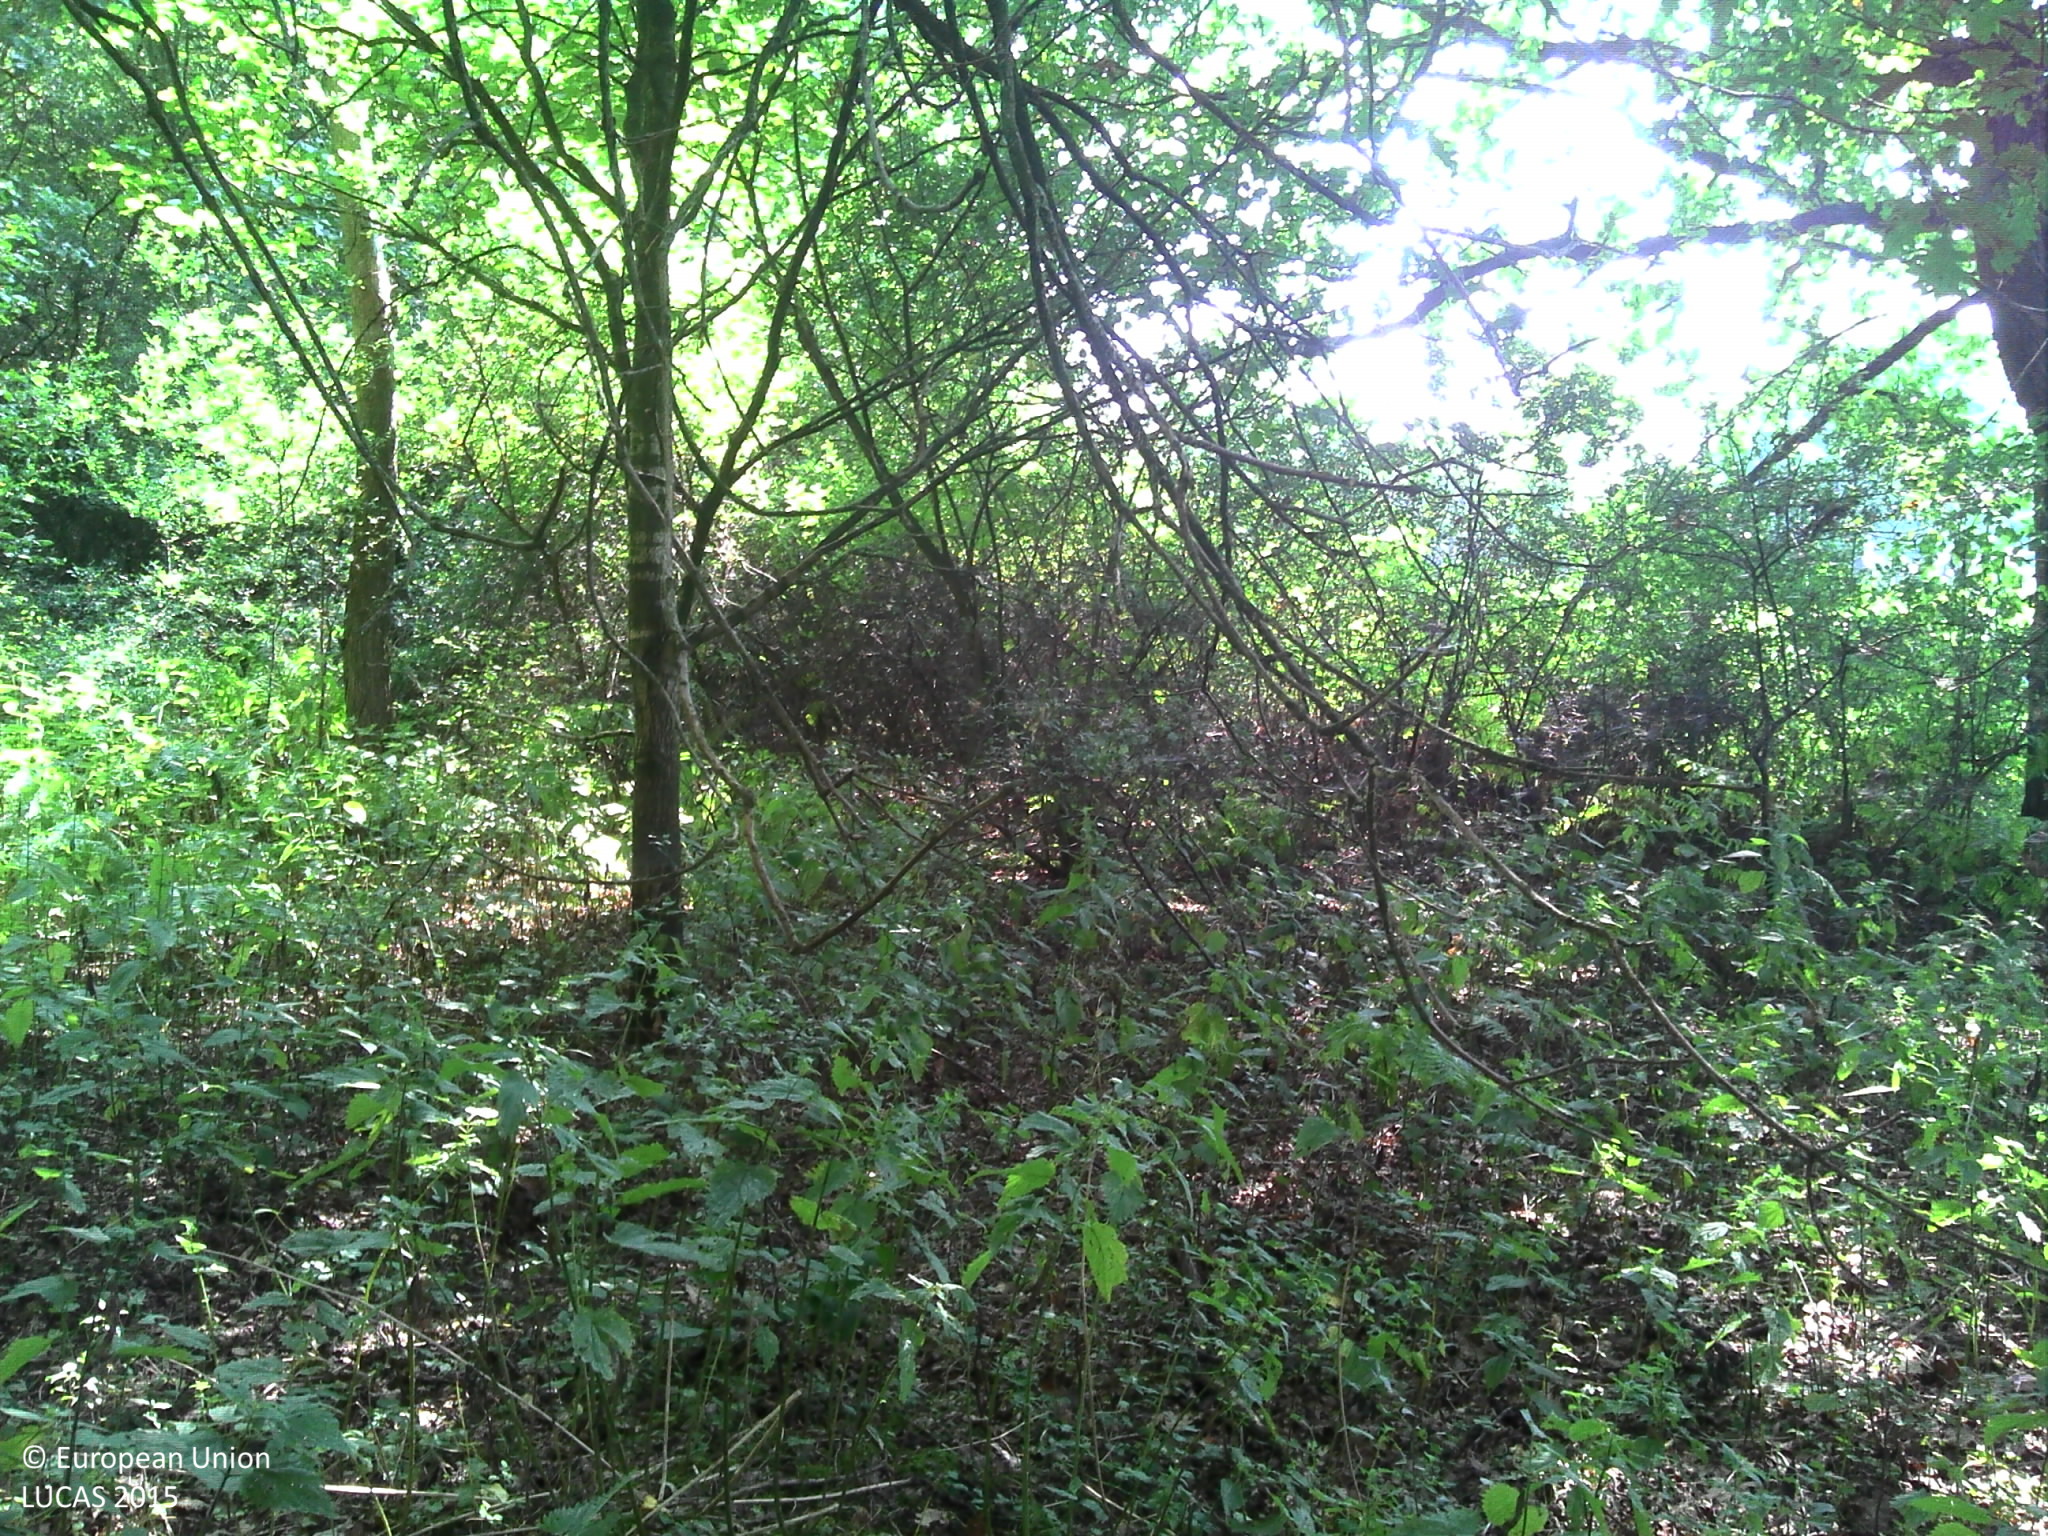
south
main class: Woodland
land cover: Broadleaved woodland
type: floodplain forest
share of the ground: > 75 %
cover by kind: broadleaved forest trees 90 %, herbaceous plants 10 %
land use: Forestry
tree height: > 5 m
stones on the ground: < 10 %
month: August
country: BE
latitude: 51.1427
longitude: 5.1232
